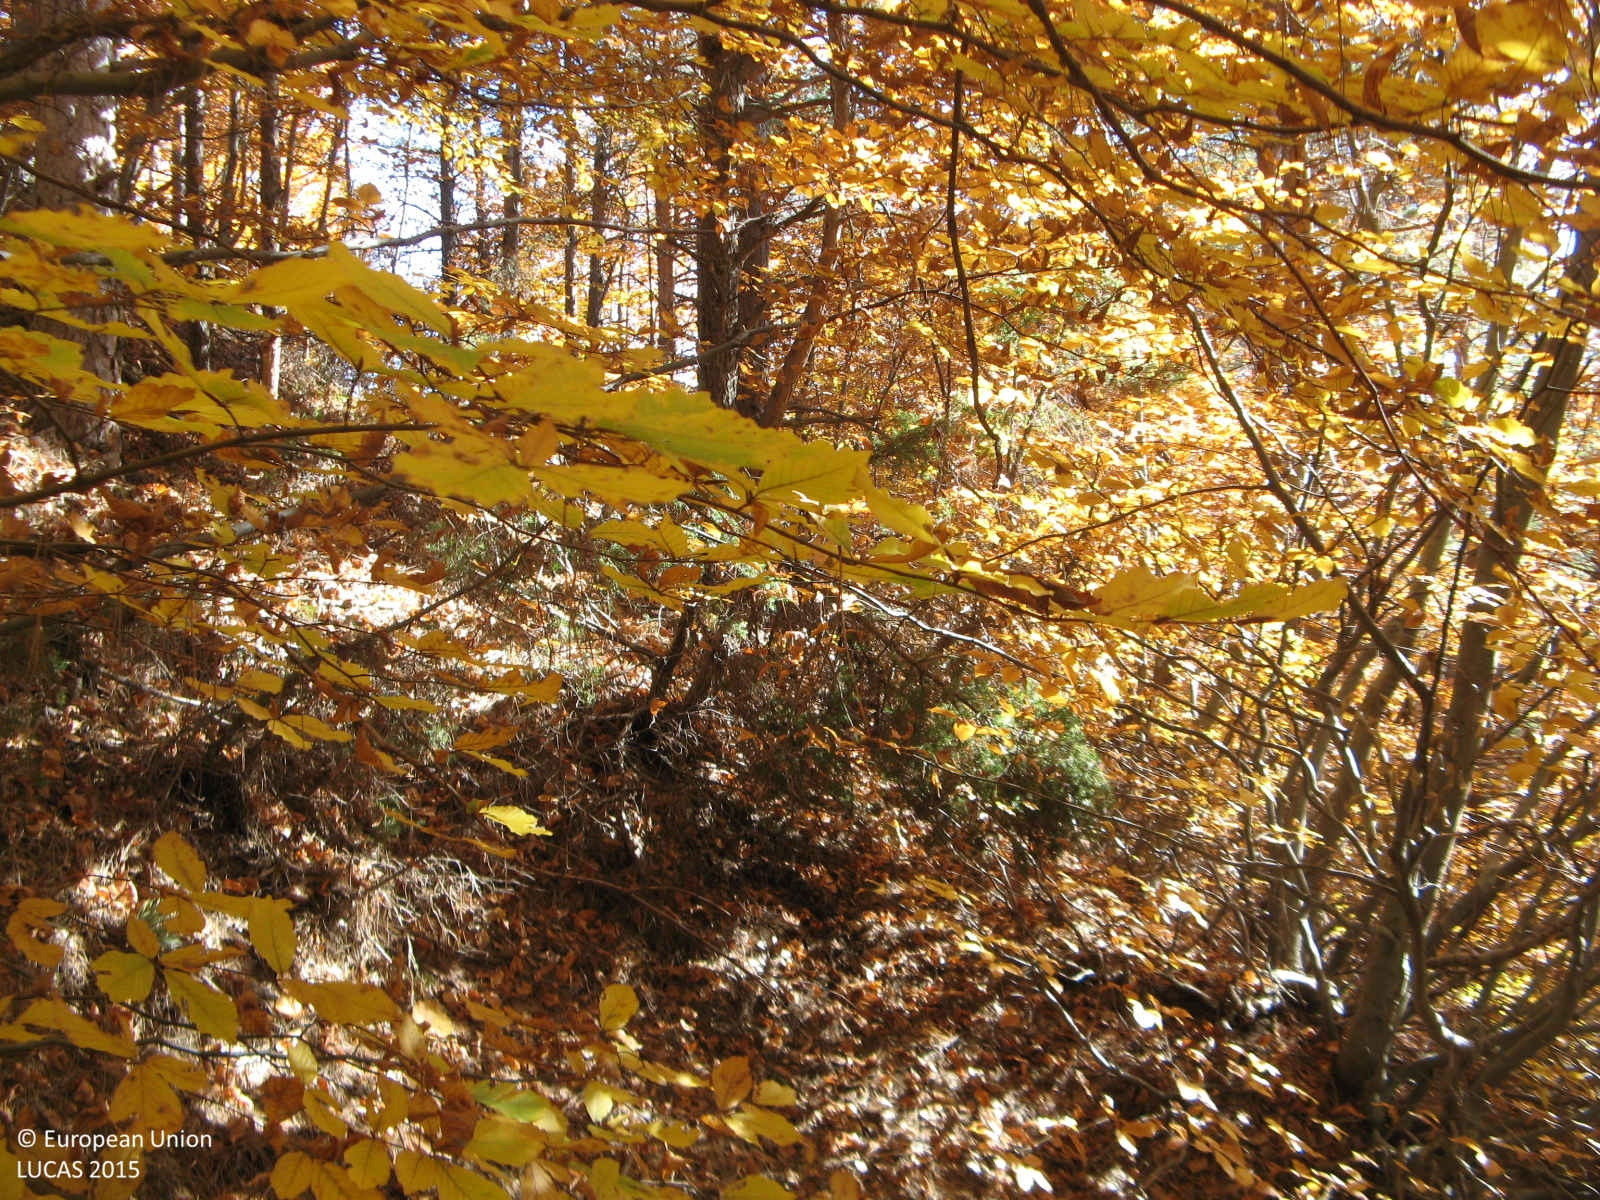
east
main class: Woodland
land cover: Pine dominated mixed woodland
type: hemiboreal forest and nemoral coniferous forest and mixed broadleaved-coniferous forest
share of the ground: > 75 %
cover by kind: coniferous forest trees 75 %, broadleaved forest trees 25 %
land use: Forestry
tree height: > 5 m
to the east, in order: Pine dominated mixed woodland; Grassland with sparse tree/shrub cover; Rocks and stones; Pine dominated mixed woodland; Rocks and stones; Shrubland with sparse tree cover; Tracks; Broadleaved woodland; Rivers and streams; Broadleaved woodland
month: November
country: BG
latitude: 41.5268
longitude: 25.1394
